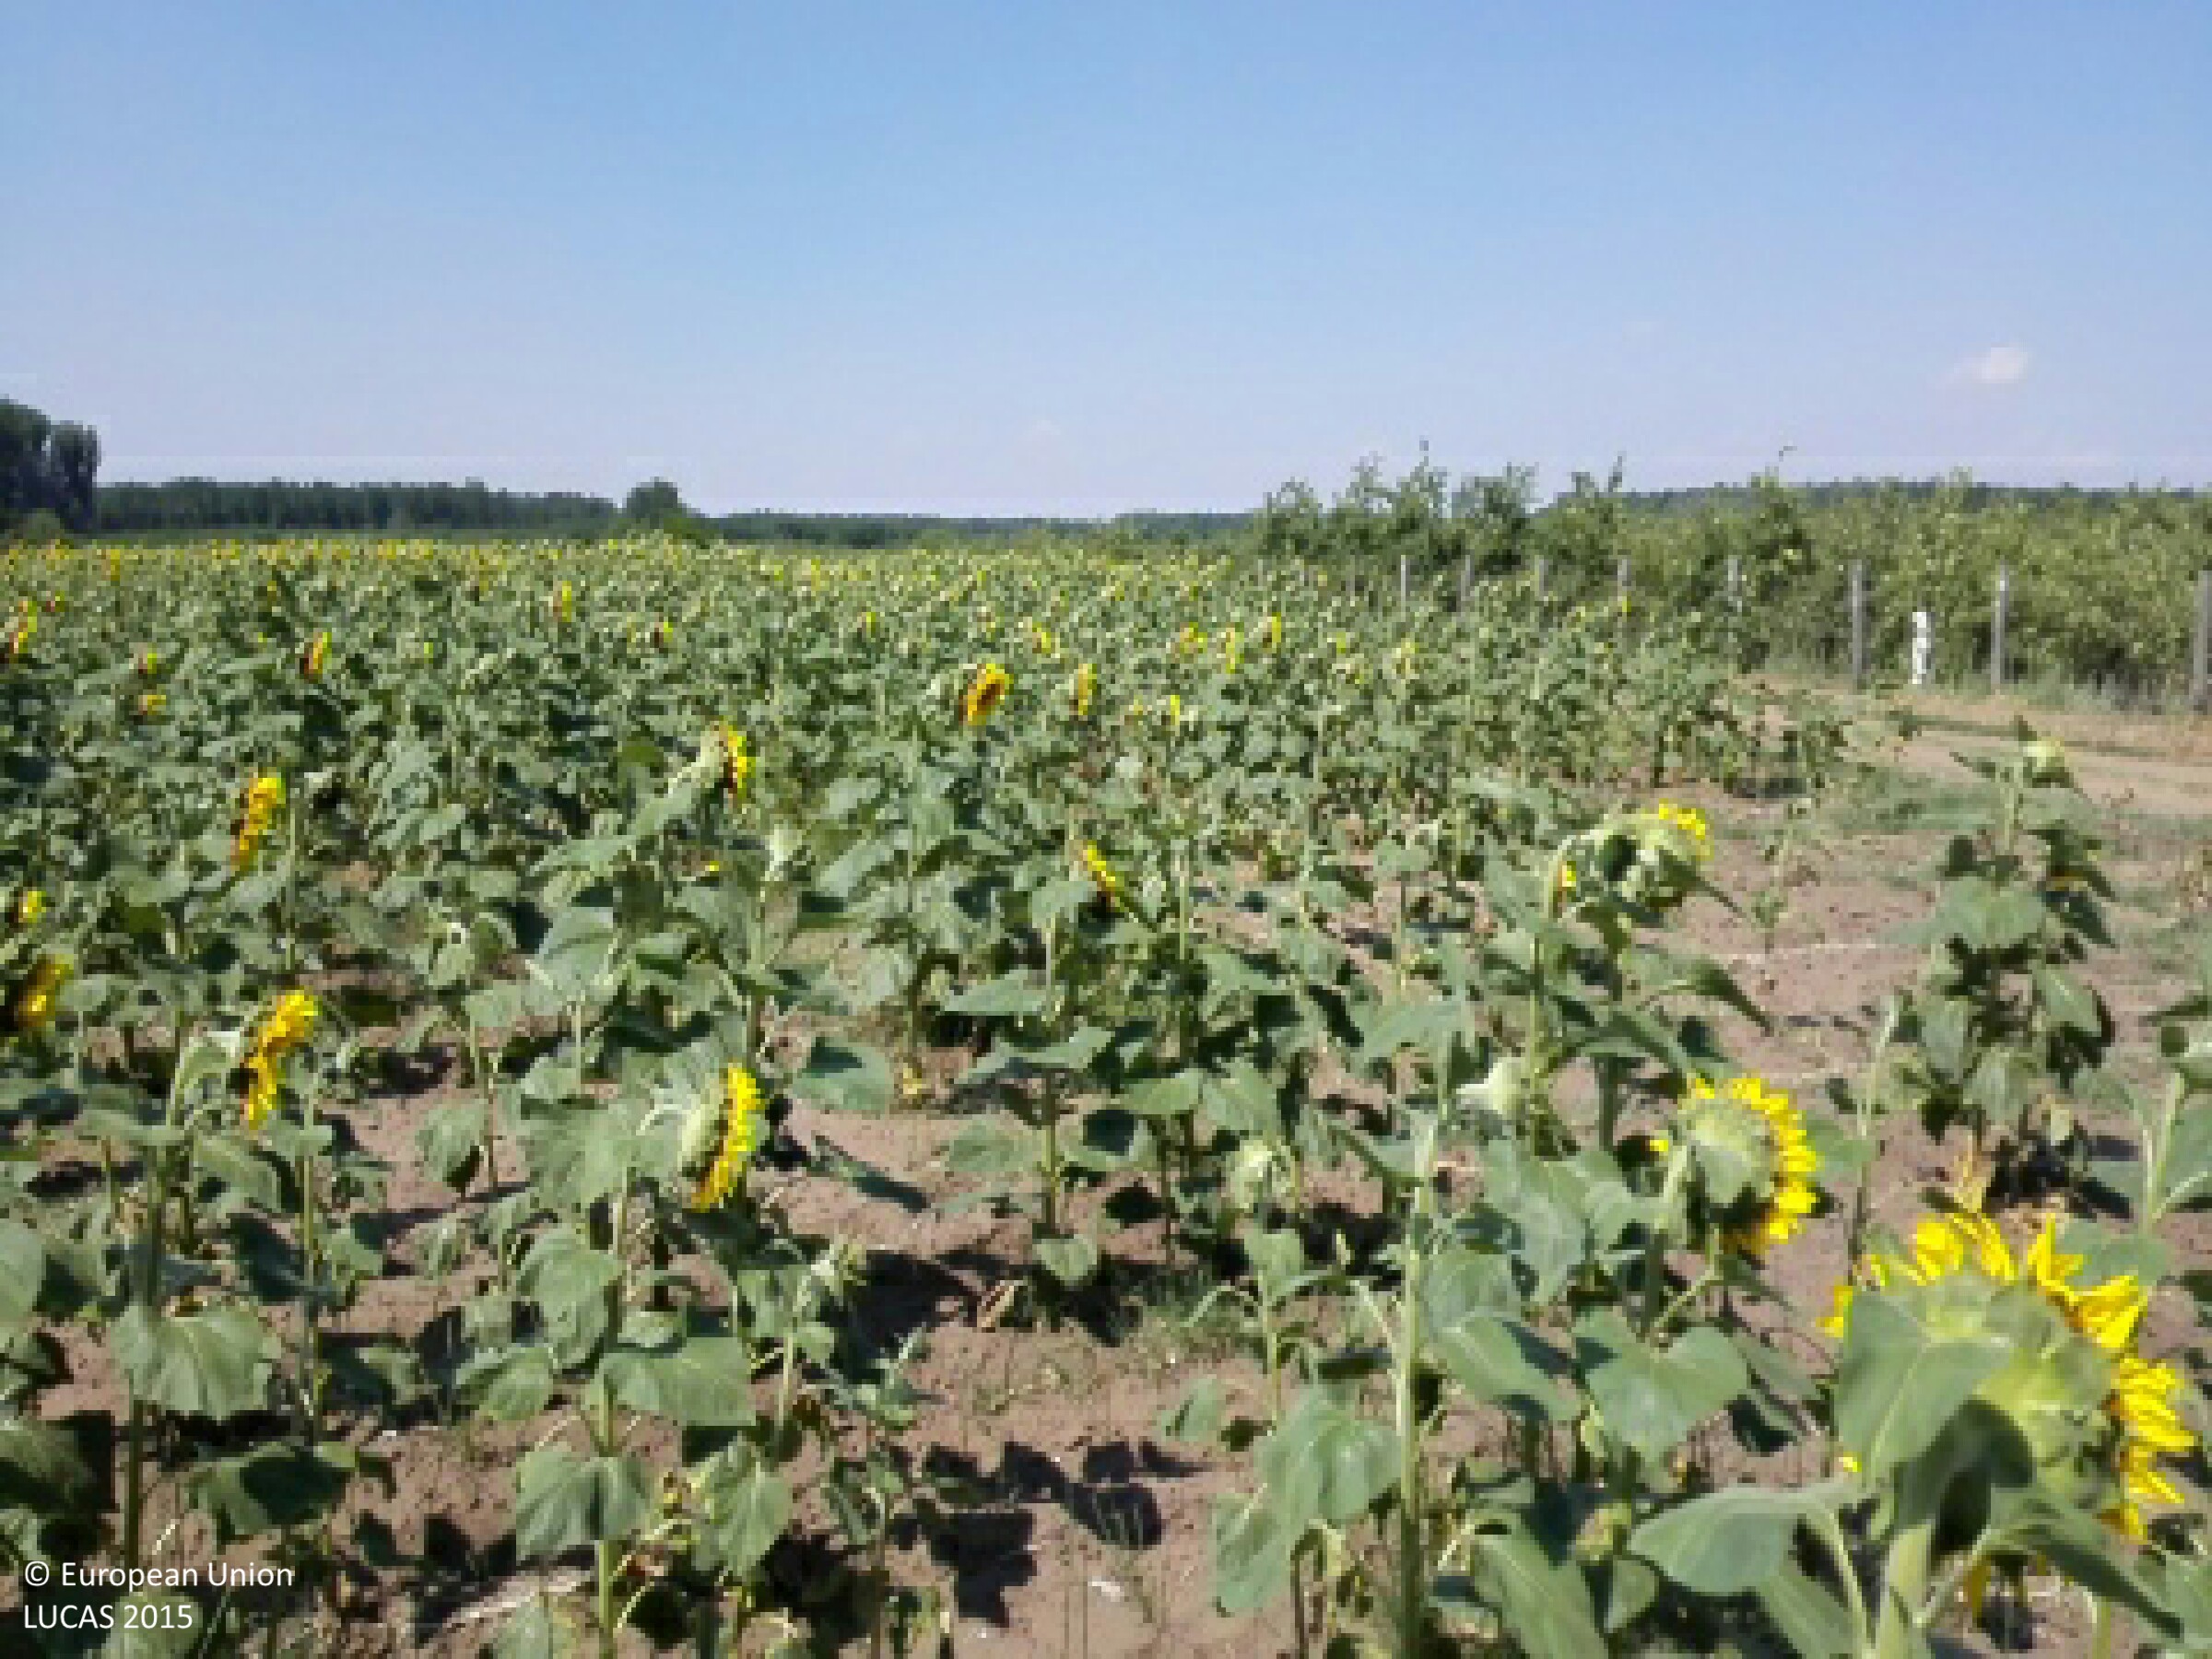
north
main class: Cropland
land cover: Sunflower
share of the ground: 10 - 25 %
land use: Agriculture (excluding fallow land and kitchen gardens)
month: July
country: HU
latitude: 47.6354
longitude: 21.6917
